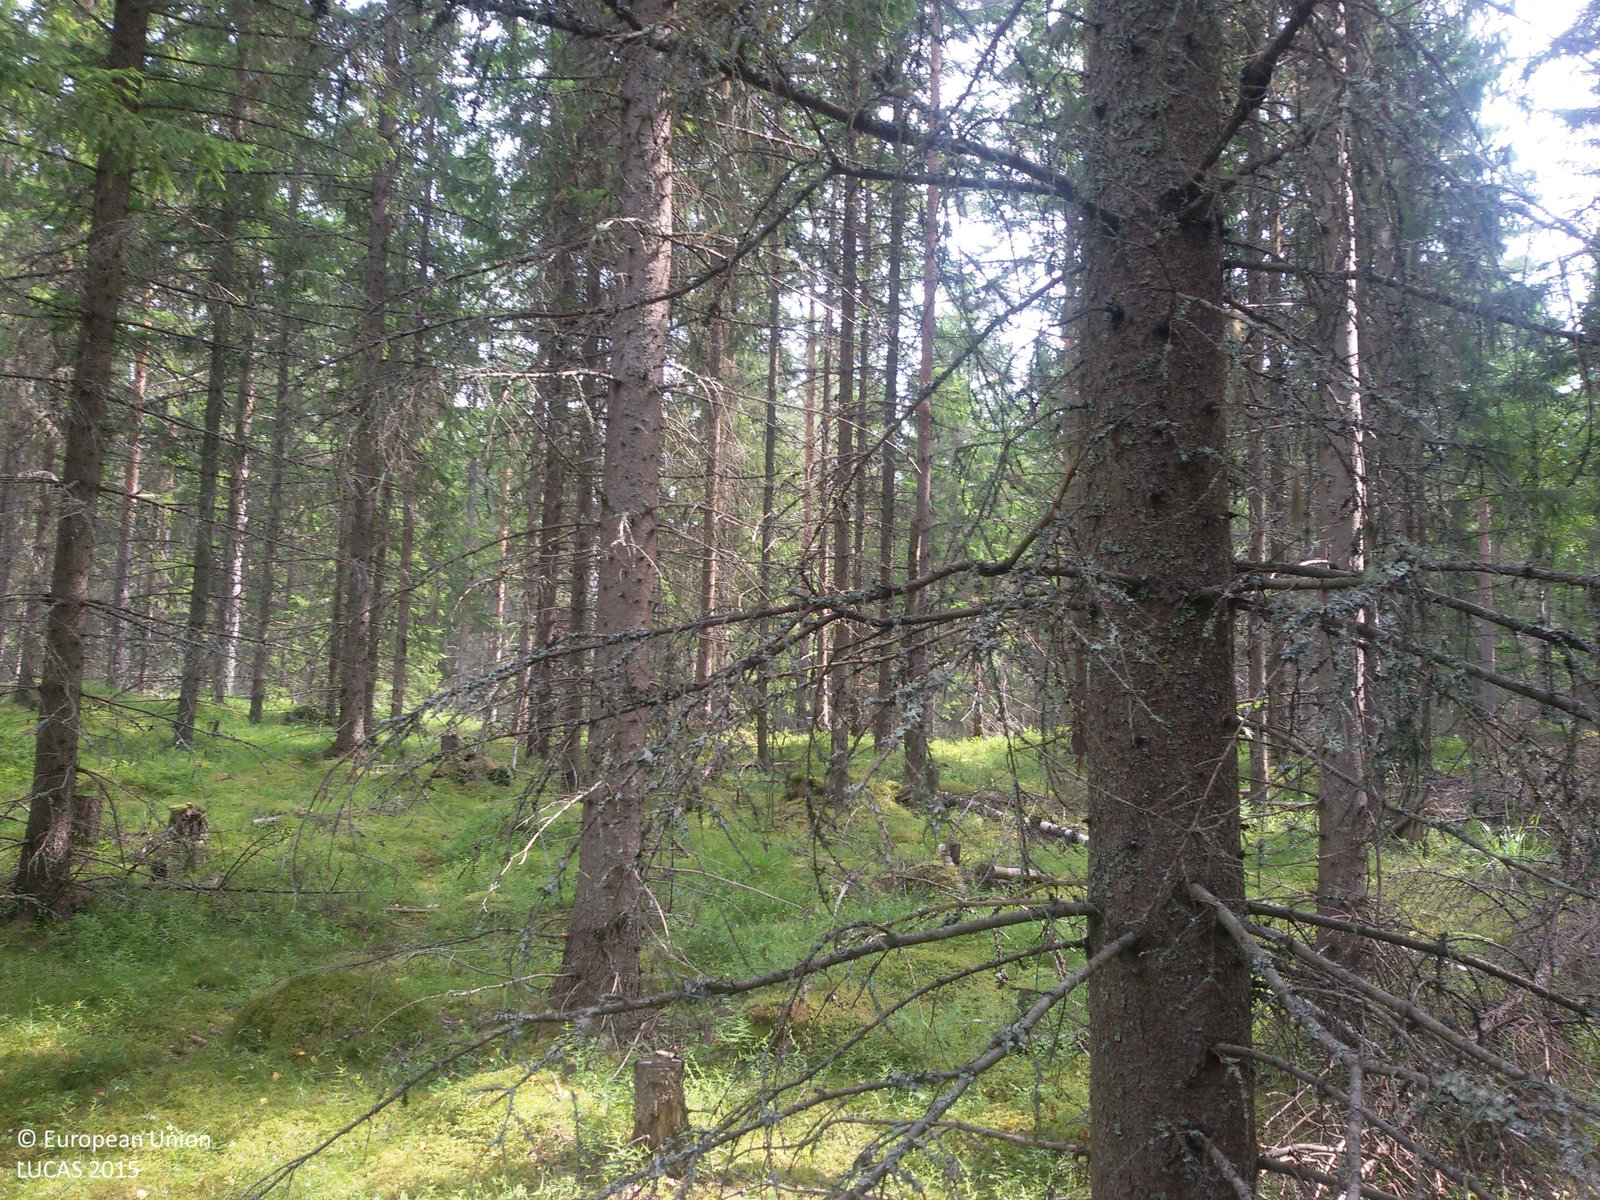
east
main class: Woodland
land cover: Spruce dominated coniferous woodland
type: boreal forest
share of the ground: > 75 %
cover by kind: coniferous forest trees 80 %, herbaceous plants 15 %, shrubs 5 %
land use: Forestry
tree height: > 5 m
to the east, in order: Spruce dominated coniferous woodland
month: August
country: SE
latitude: 60.4571
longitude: 16.6616
